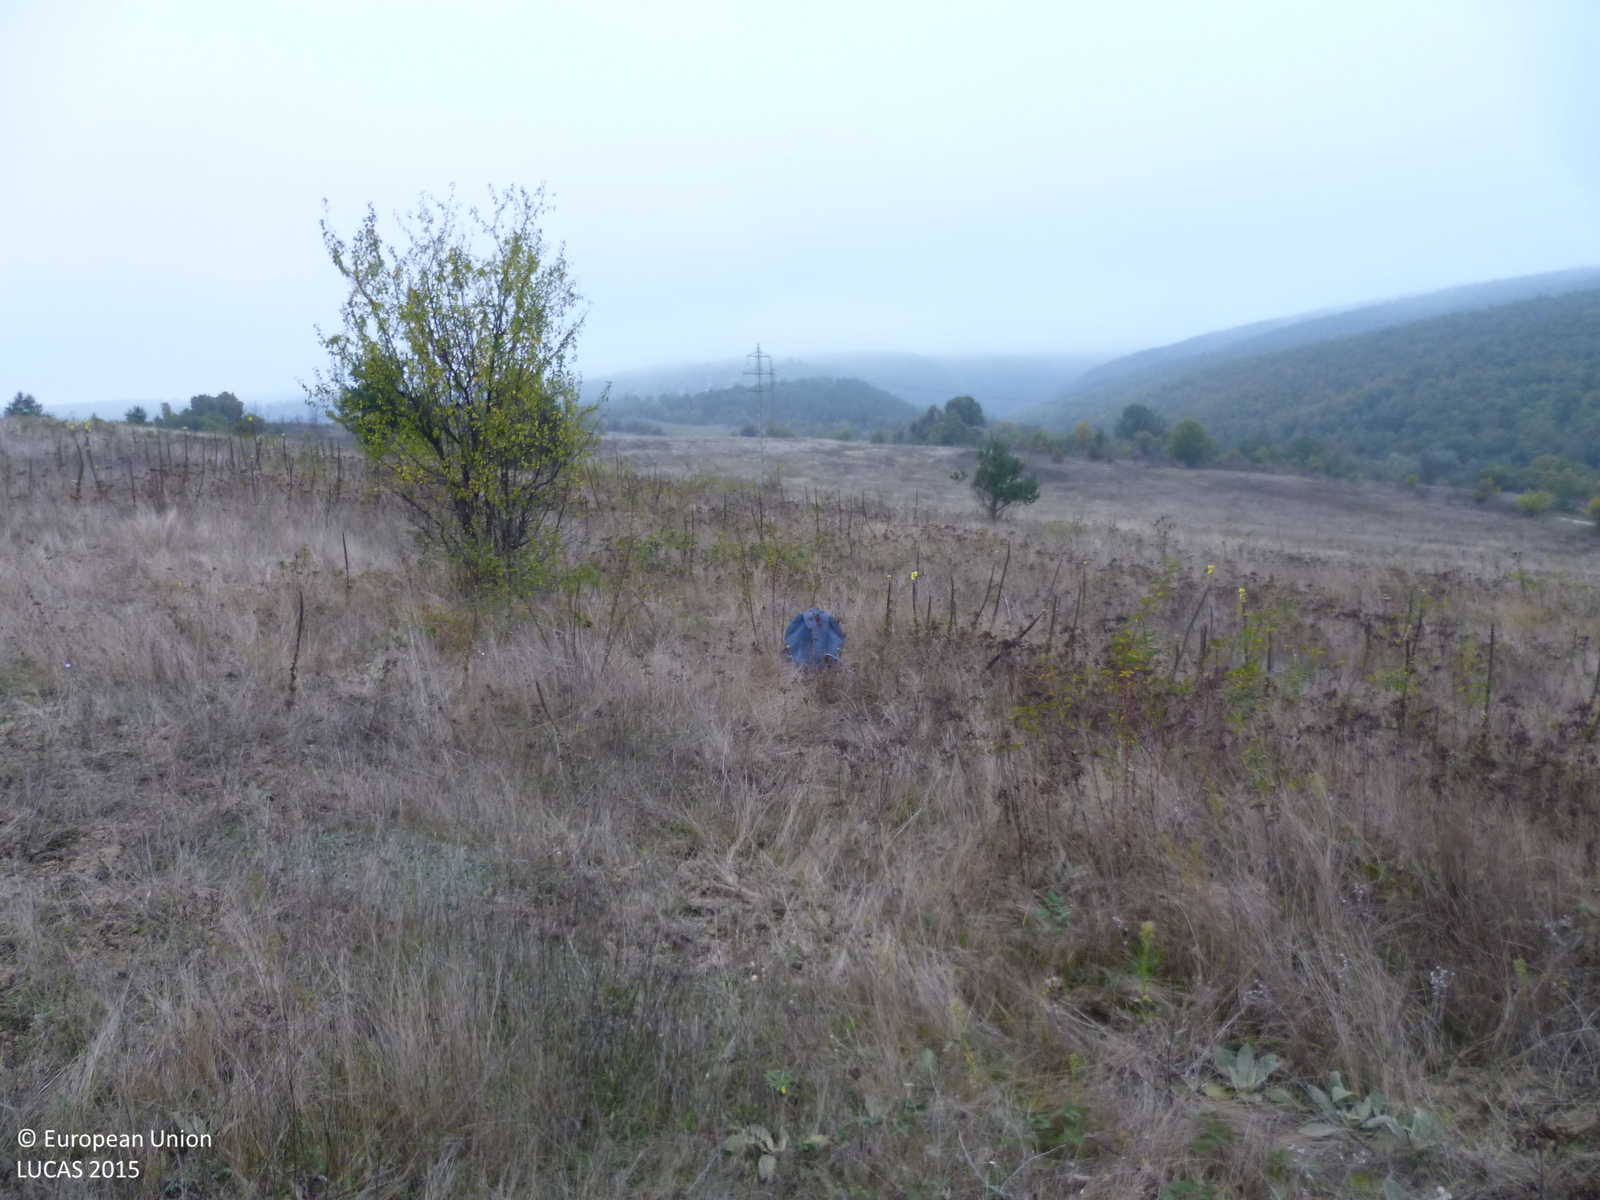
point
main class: Grassland
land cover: Grassland with sparse tree/shrub cover
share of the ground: > 75 %
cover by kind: herbaceous plants 90 %, broadleaved forest trees 5 %, shrubs 5 %
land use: Agriculture (excluding fallow land and kitchen gardens)
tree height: < 5 m
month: October
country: BG
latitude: 42.5152
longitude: 23.7562
